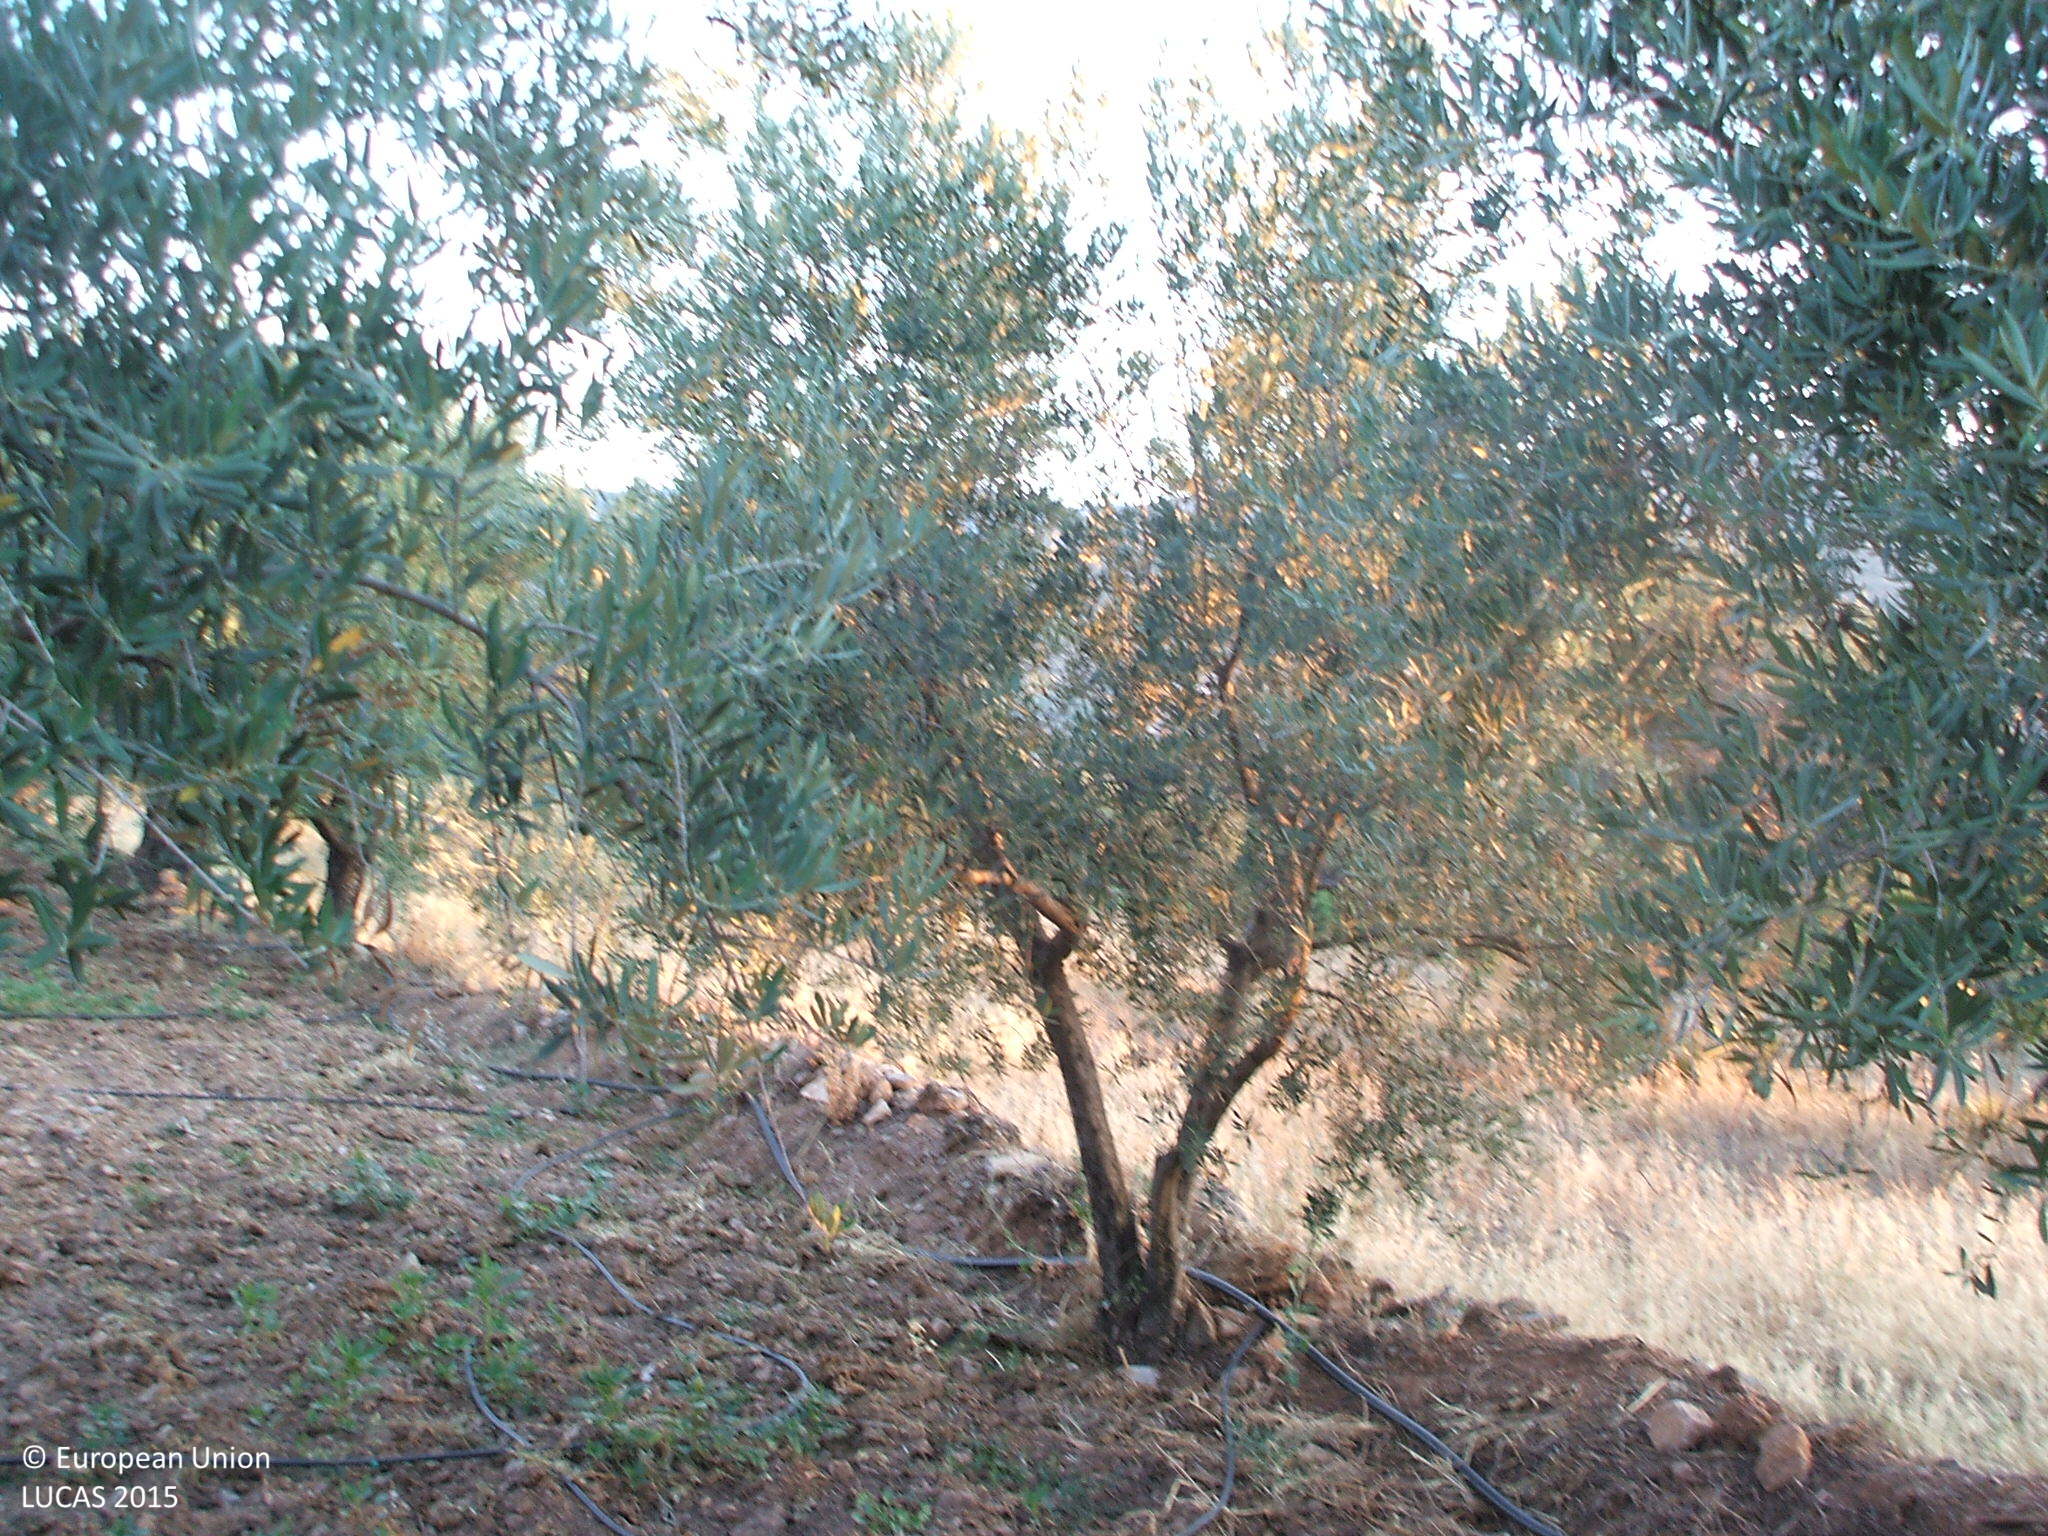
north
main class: Cropland
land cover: Olive groves
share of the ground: 25 - 50 %
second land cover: Other bare soil
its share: > 75 %
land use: Agriculture (excluding fallow land and kitchen gardens)
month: July
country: ES
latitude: 36.9797
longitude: -2.8654
